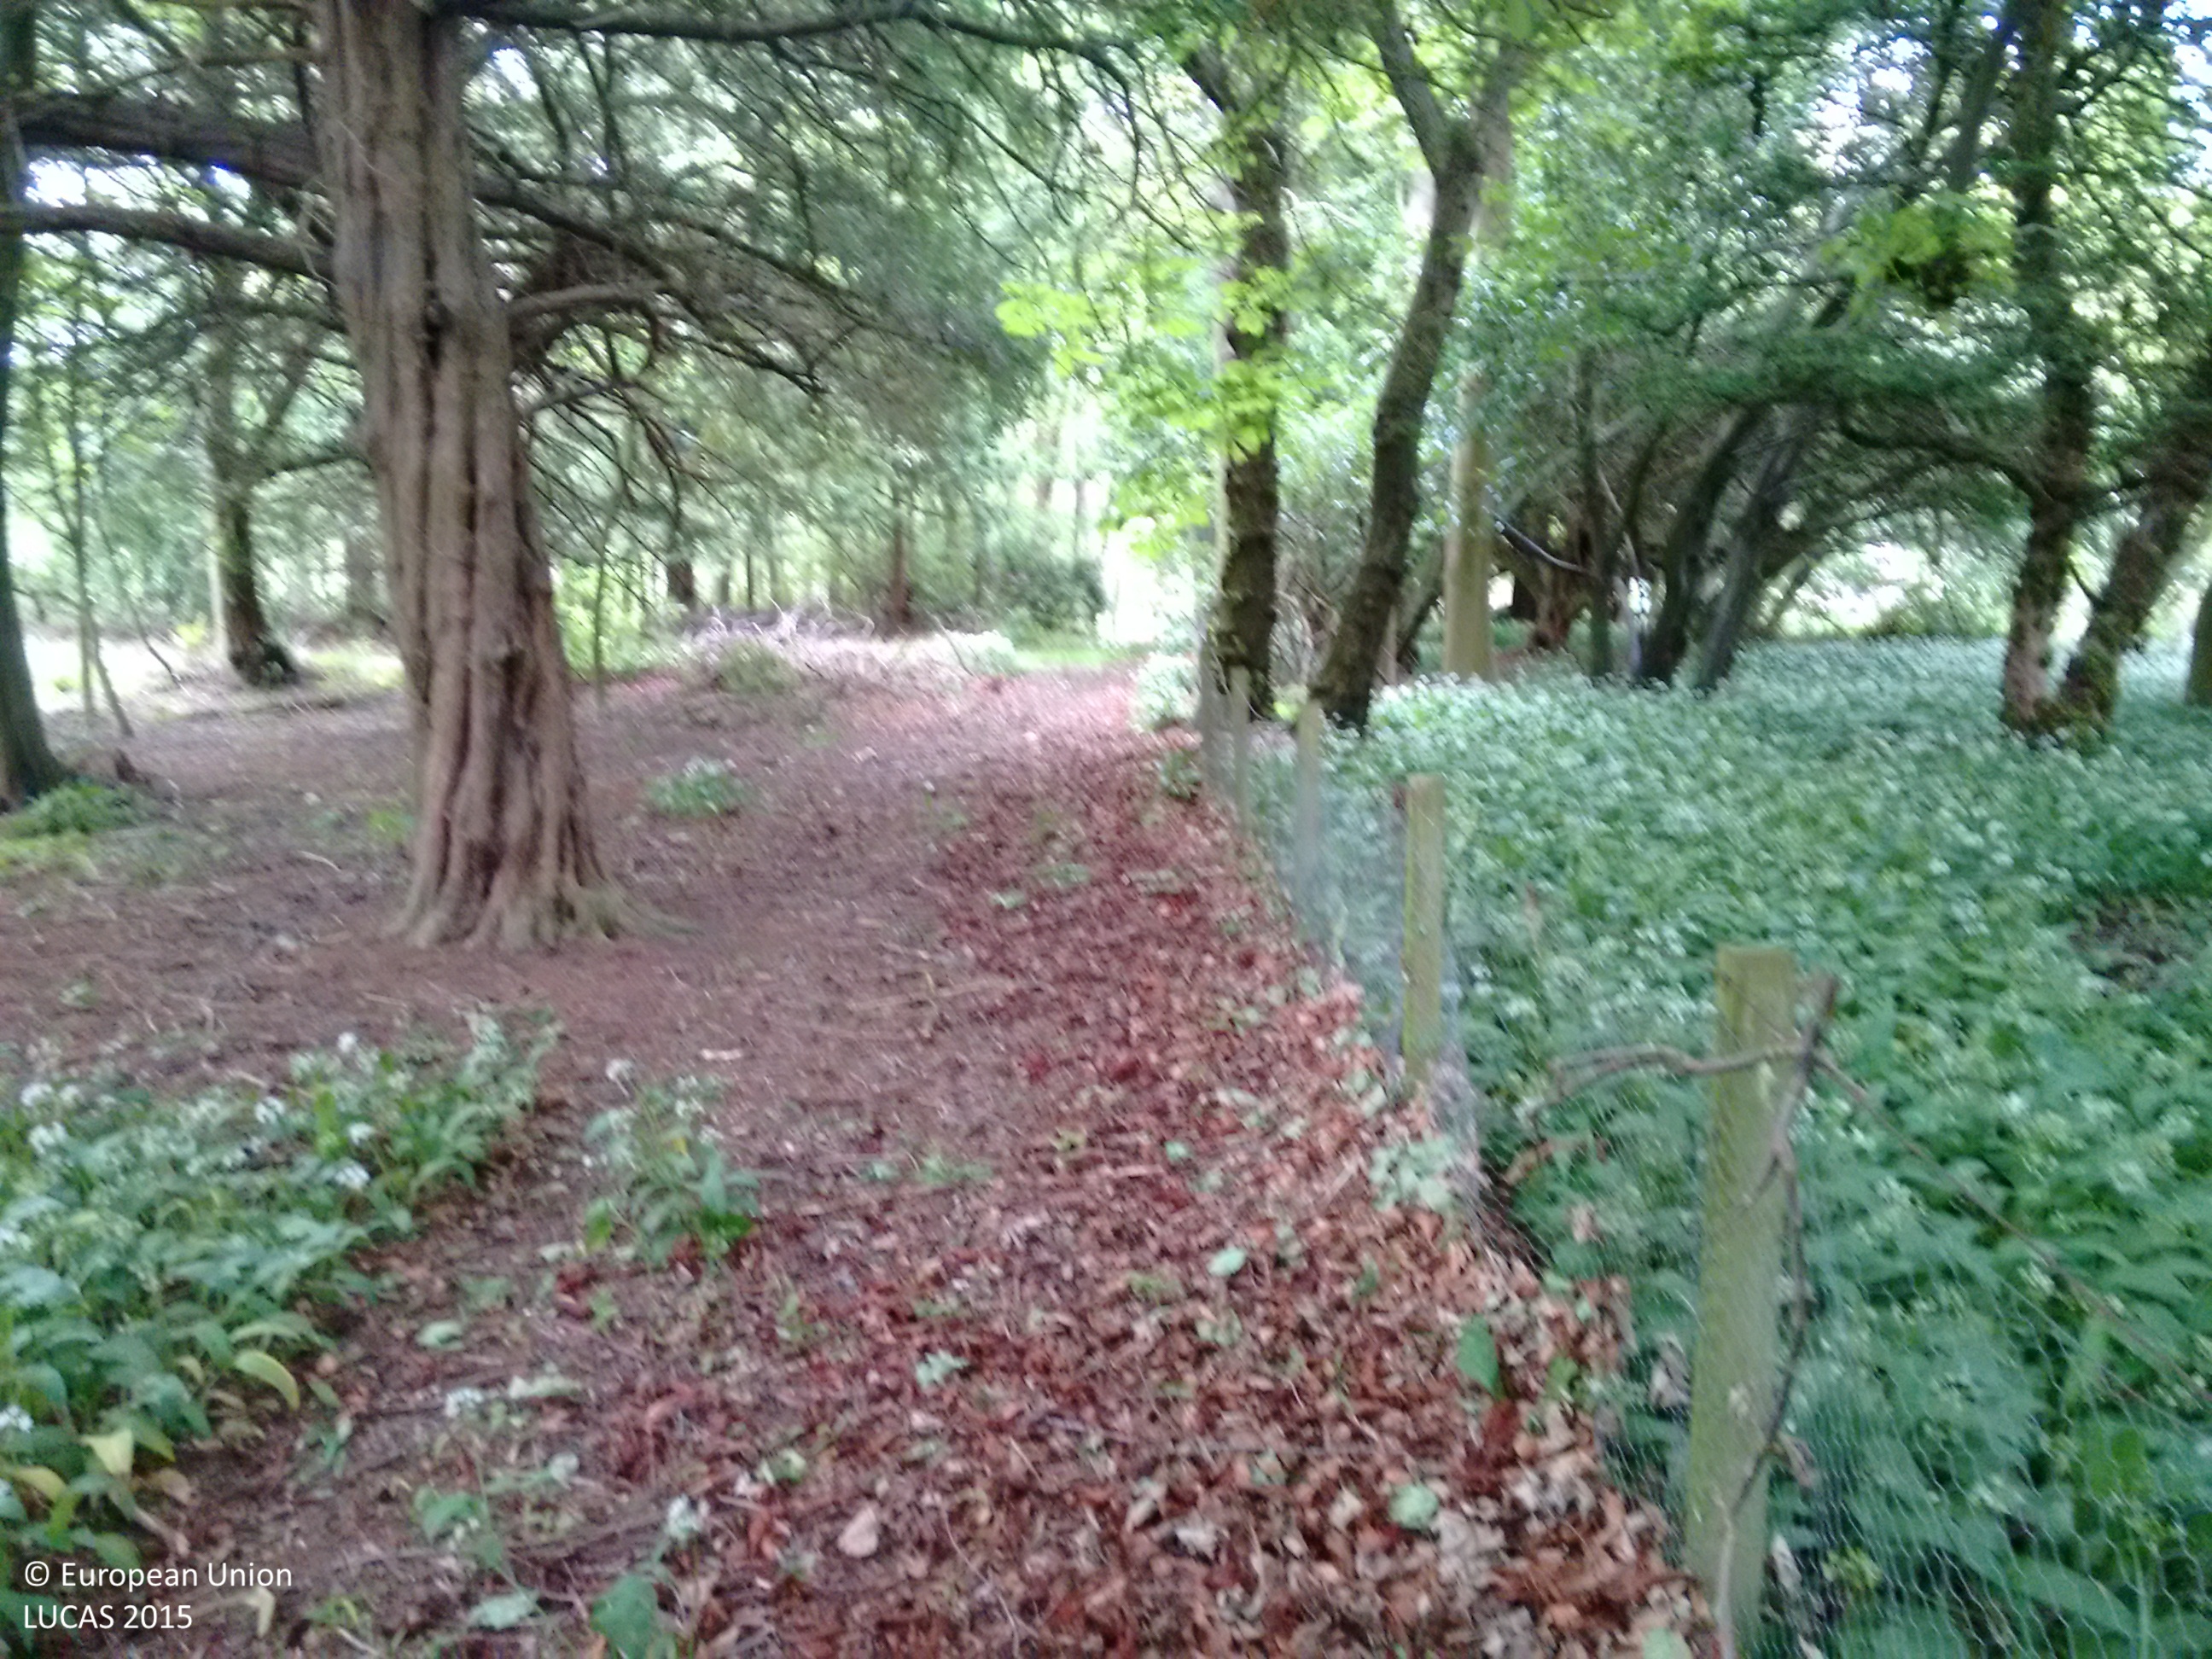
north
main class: Woodland
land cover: Other mixed woodland
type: exotic forest
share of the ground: > 75 %
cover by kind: broadleaved forest trees 75 %, coniferous forest trees 25 %
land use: Semi-natural and natural areas not in use
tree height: > 5 m
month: June
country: GB
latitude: 55.5506
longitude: -1.7955
